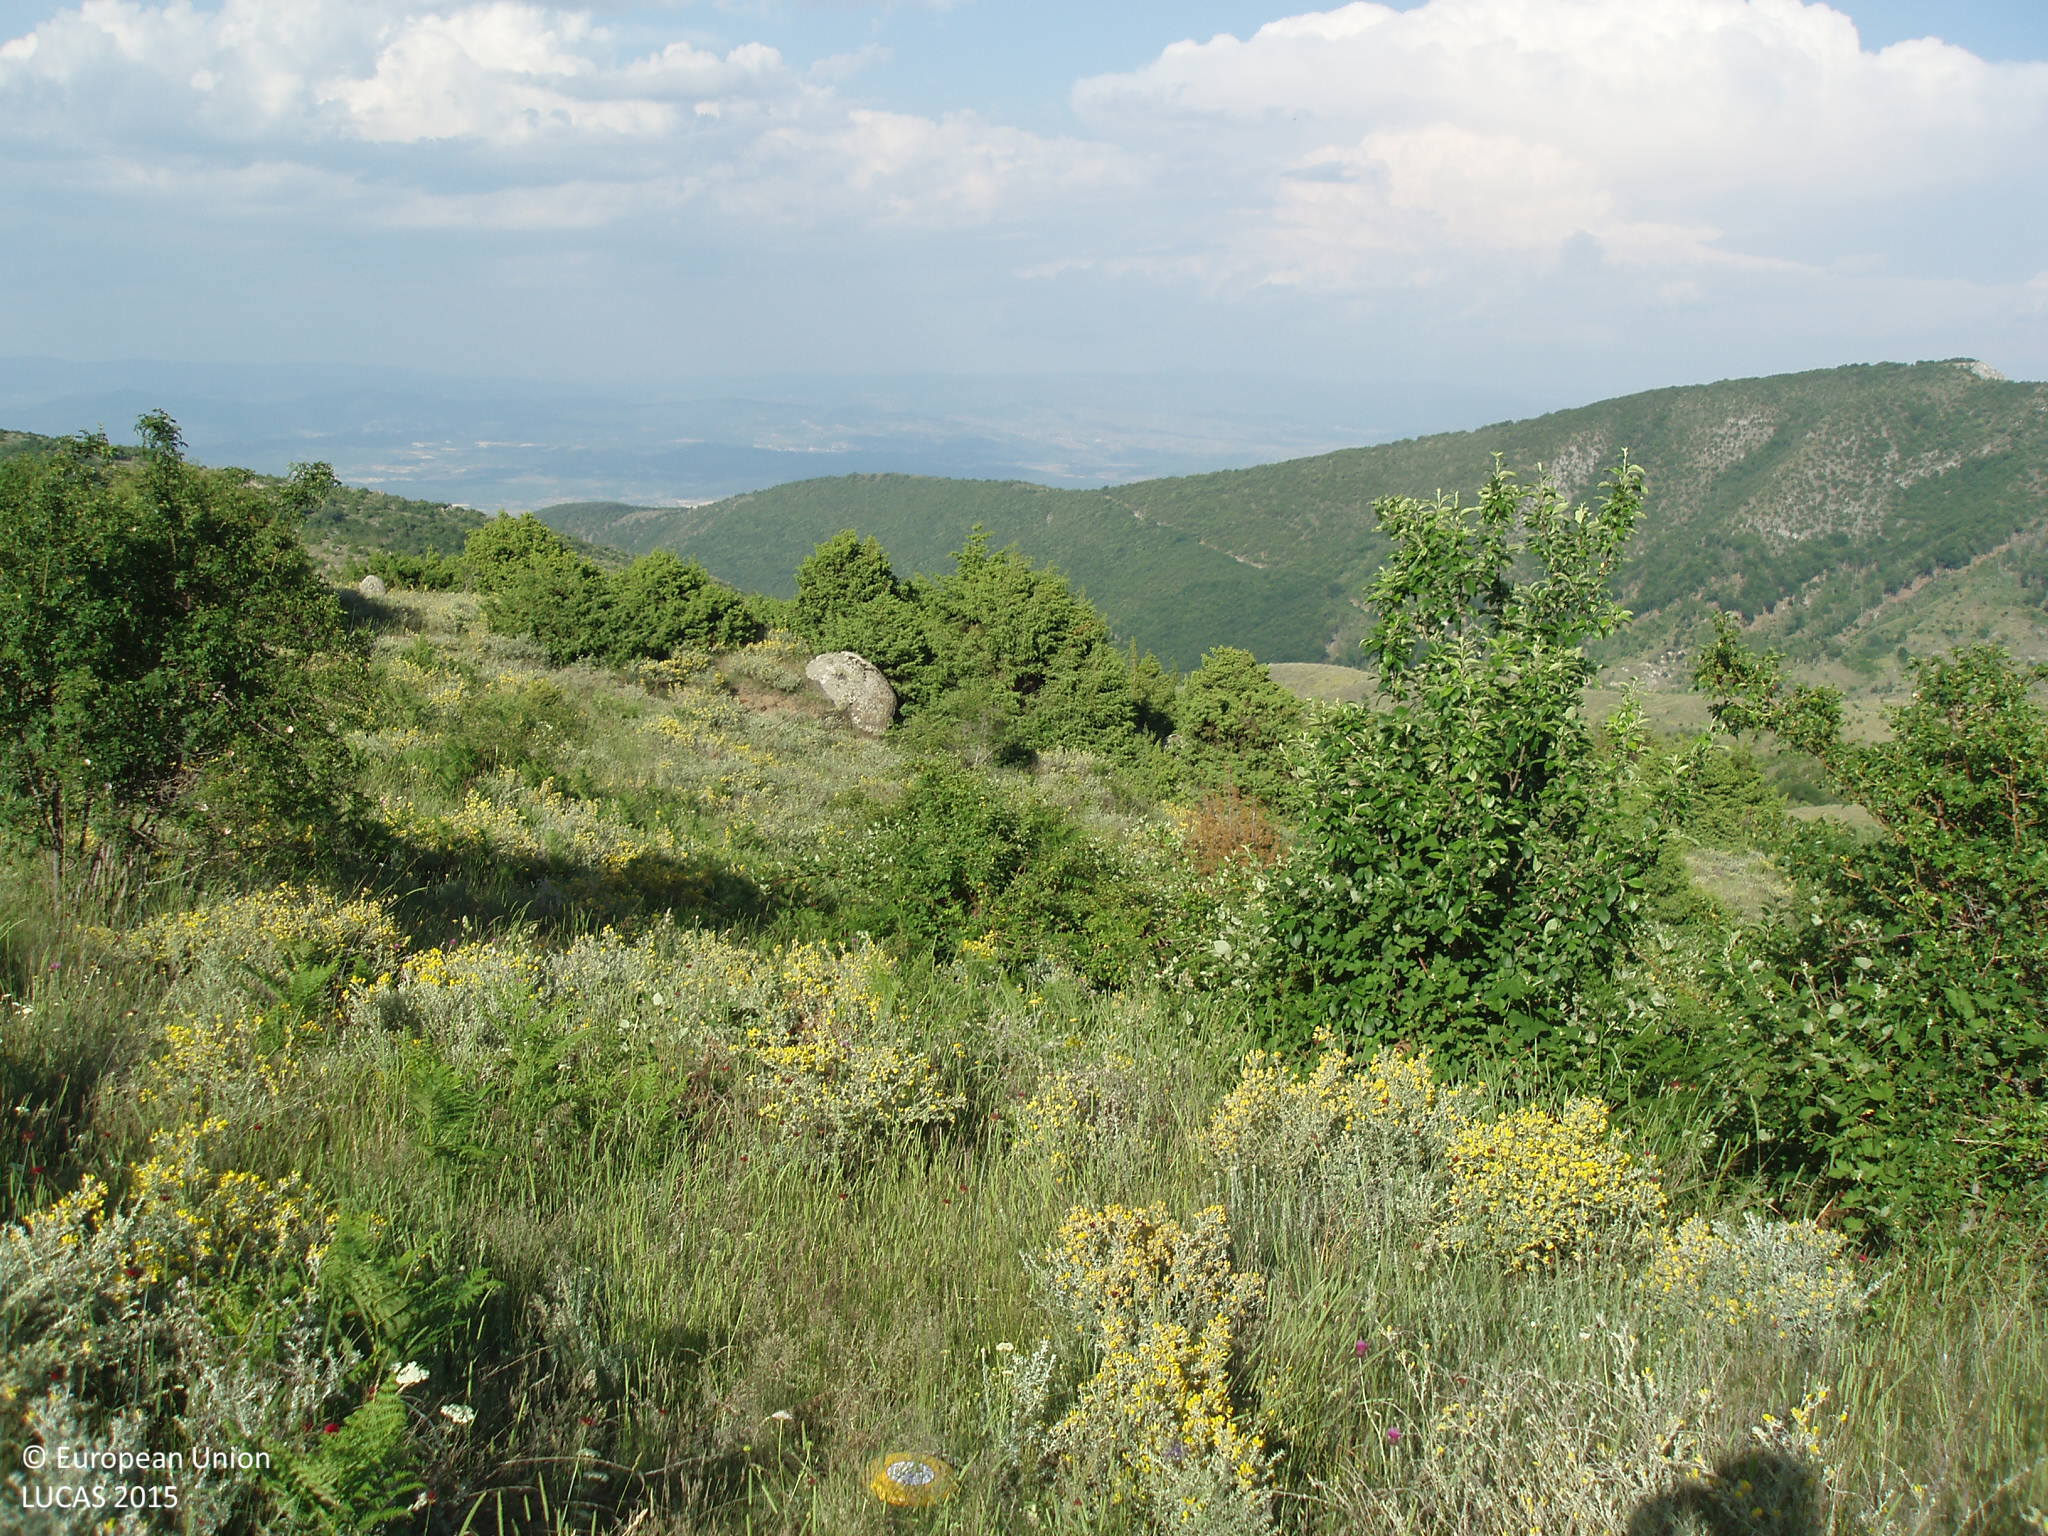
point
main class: Shrubland
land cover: Shrubland with sparse tree cover
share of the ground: 50 - 75 %
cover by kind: shrubs 65 %, herbaceous plants 30 %, broadleaved forest trees 5 %
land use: Semi-natural and natural areas not in use
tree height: < 5 m
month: June
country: BG
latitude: 41.4960
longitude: 23.7189
